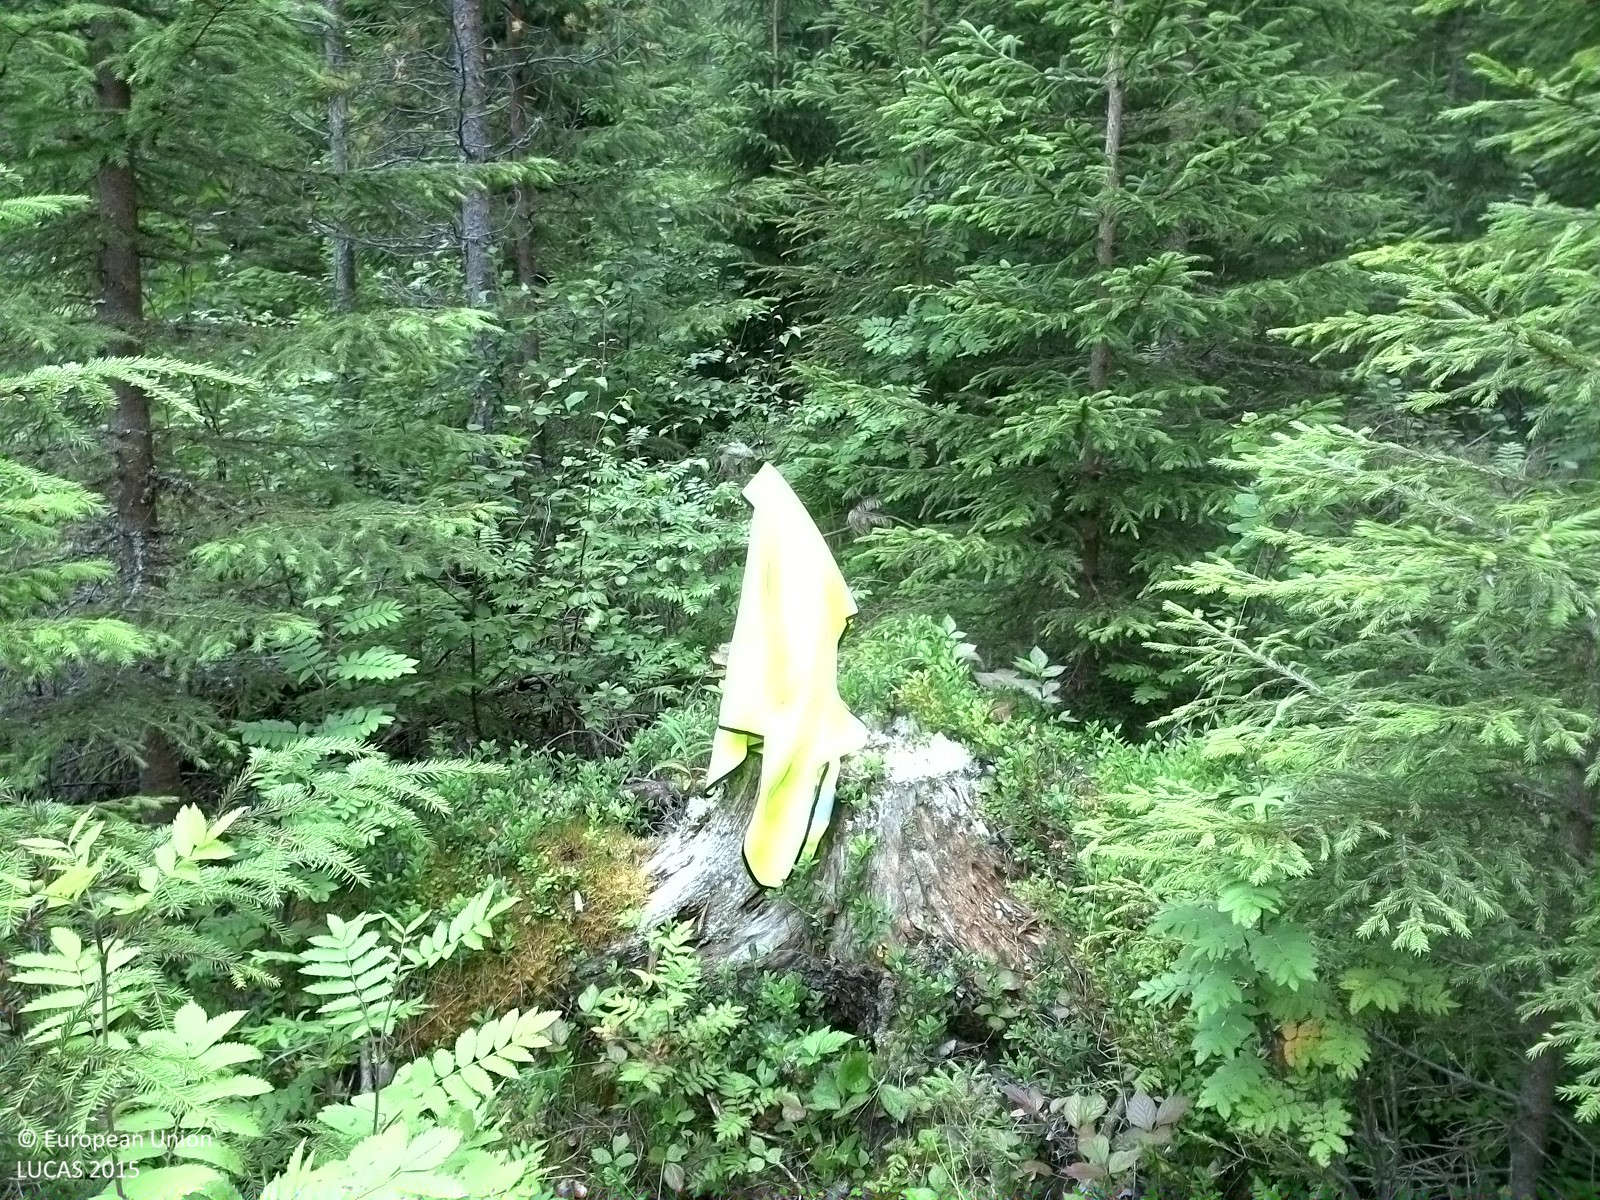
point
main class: Woodland
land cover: Spruce dominated coniferous woodland
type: boreal forest
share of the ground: 50 - 75 %
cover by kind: coniferous forest trees 60 %, shrubs 40 %
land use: Forestry
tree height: < 5 m
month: August
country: SE
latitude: 62.5564
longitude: 17.0393
